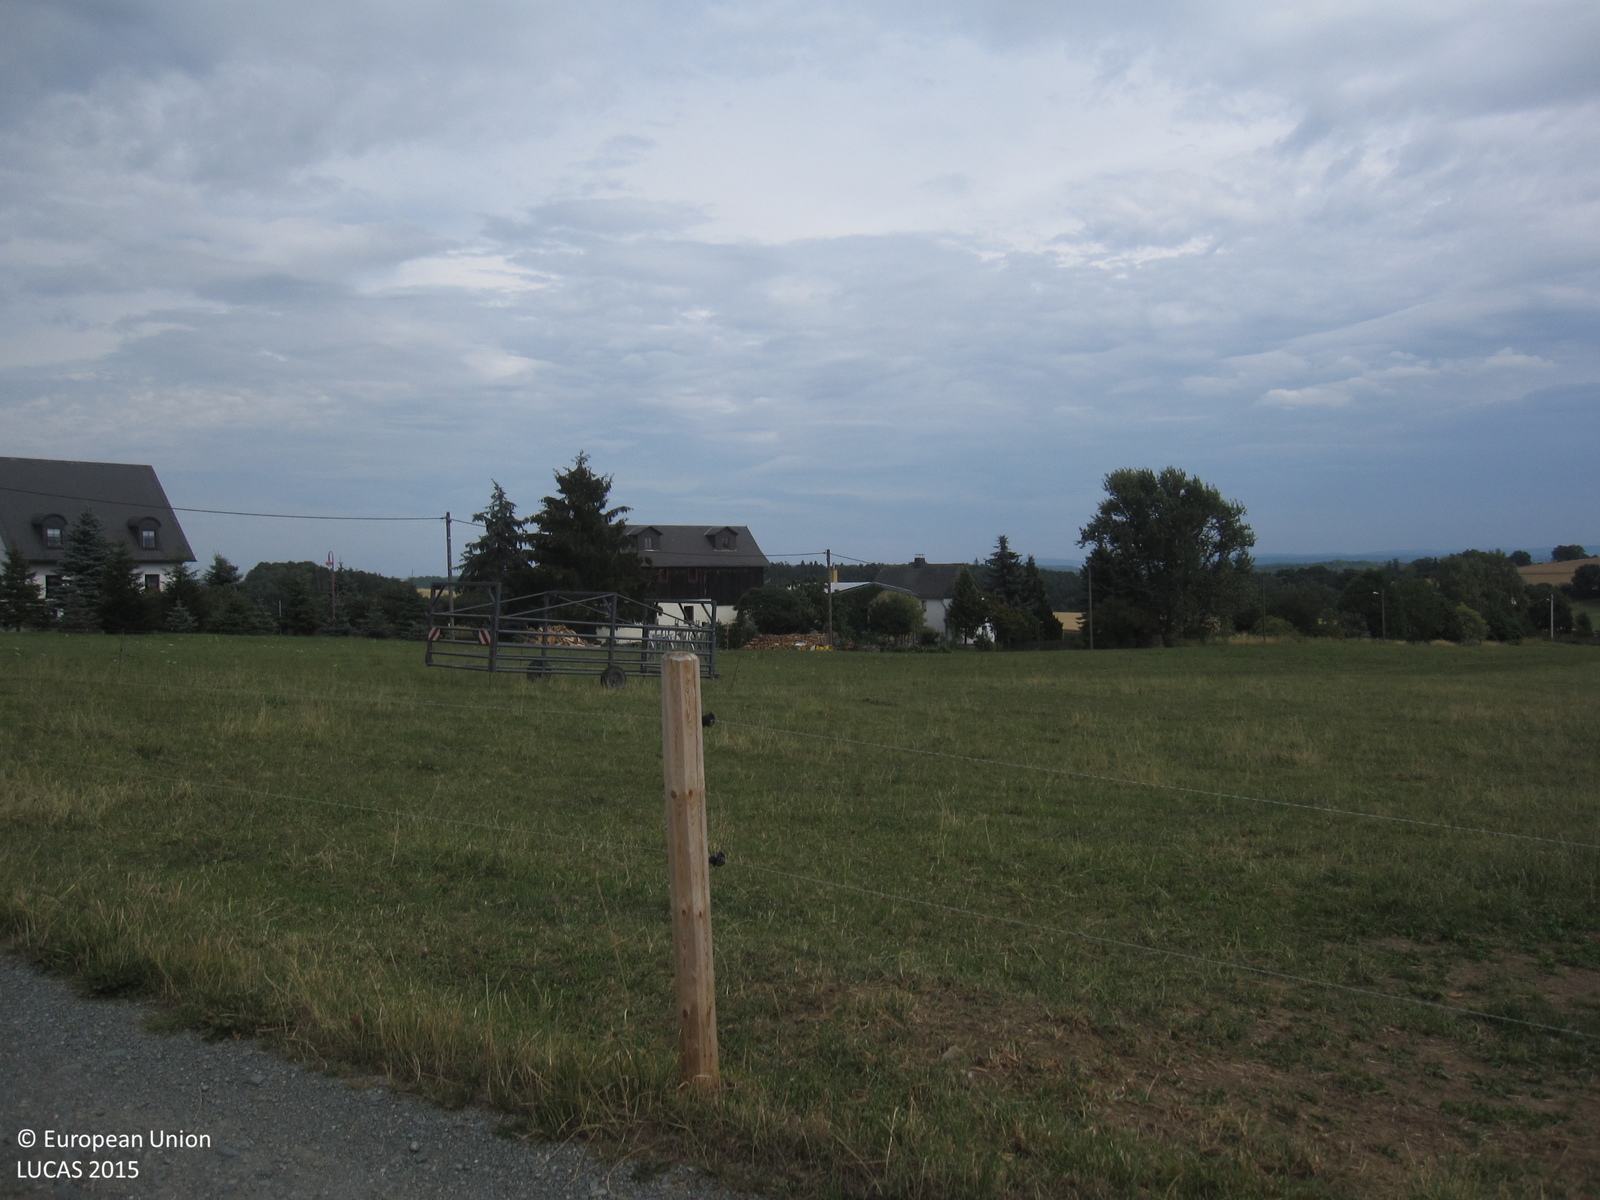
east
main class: Woodland
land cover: Broadleaved woodland
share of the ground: 25 - 50 %
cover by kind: herbaceous plants 65 %, broadleaved forest trees 35 %
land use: Residential
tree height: > 5 m
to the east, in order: Broadleaved woodland; Fences; Tracks; Fences; Grassland without tree/shrub cover; Electric lines; Grassland with sparse tree/shrub cover; Artificial constructions in urban areas; Grassland without tree/shrub cover
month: August
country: DE
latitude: 50.5601
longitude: 12.1312
